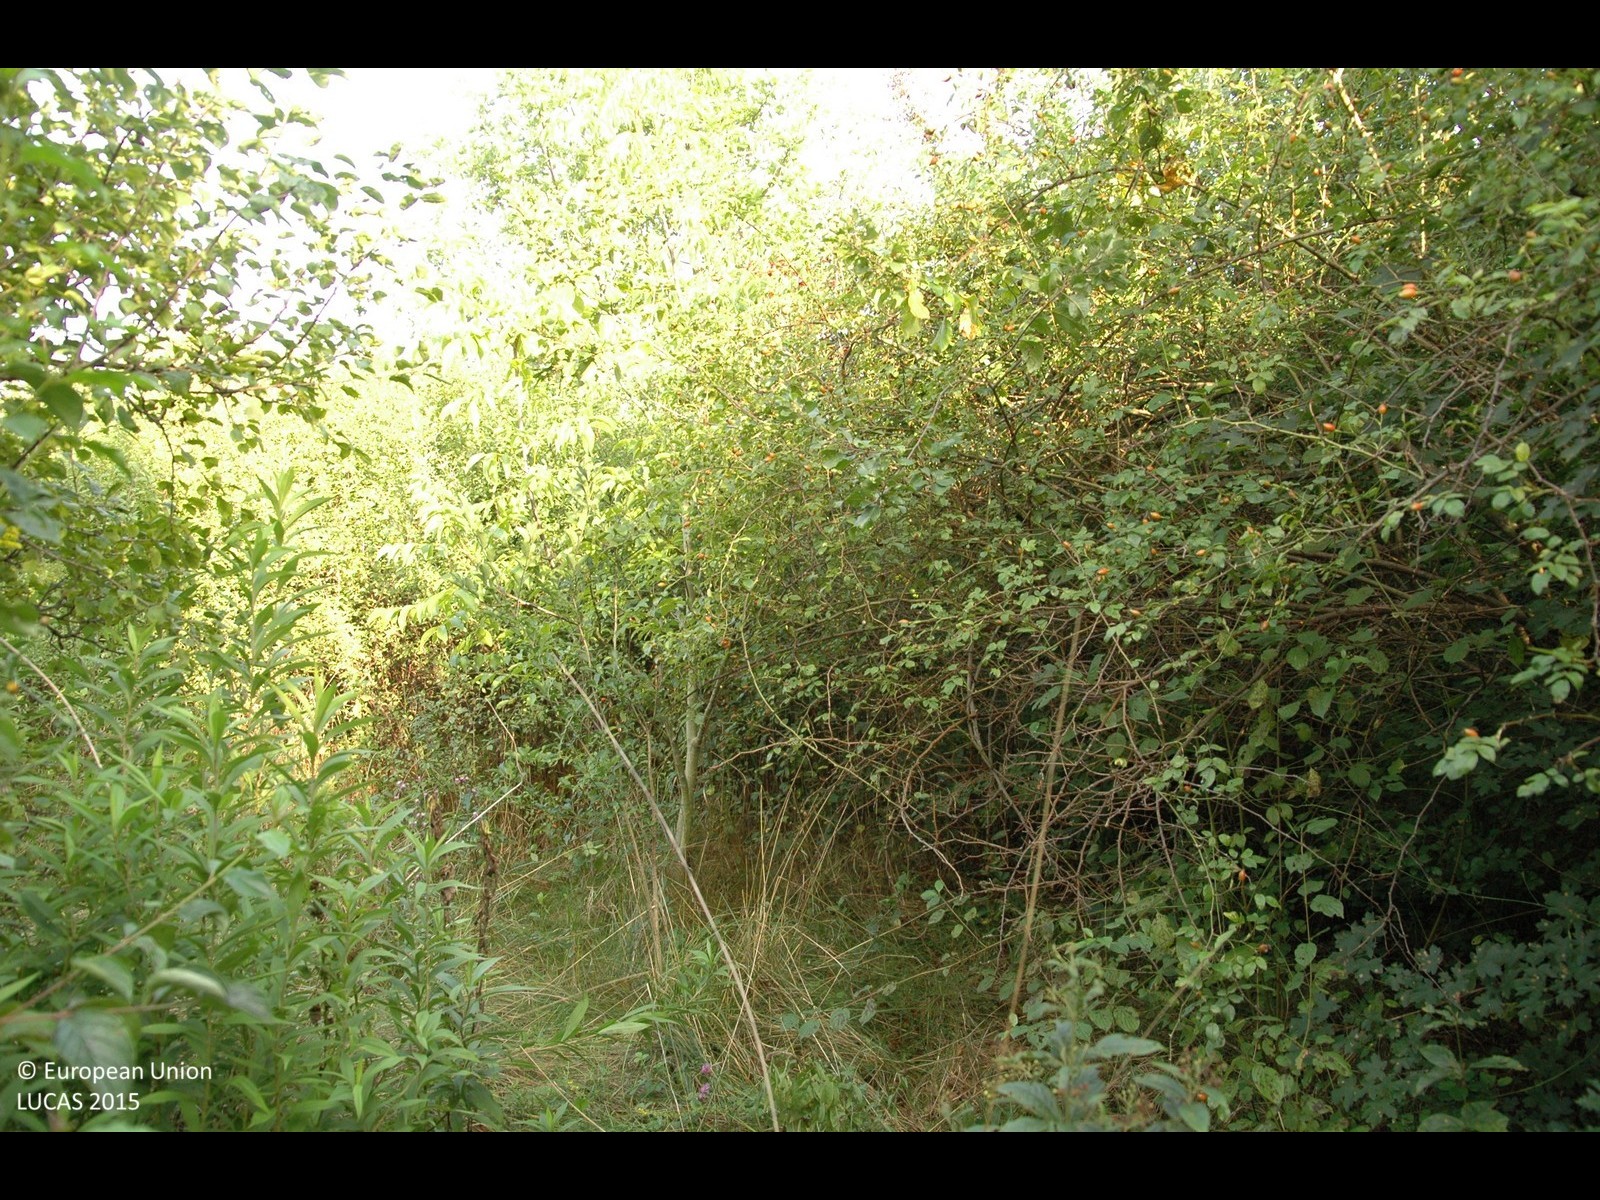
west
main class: Shrubland
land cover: Shrubland with sparse tree cover
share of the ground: > 75 %
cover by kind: shrubs 95 %, broadleaved forest trees 5 %
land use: Semi-natural and natural areas not in use
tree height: > 5 m
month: August
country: HR
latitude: 45.8152
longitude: 16.1113
